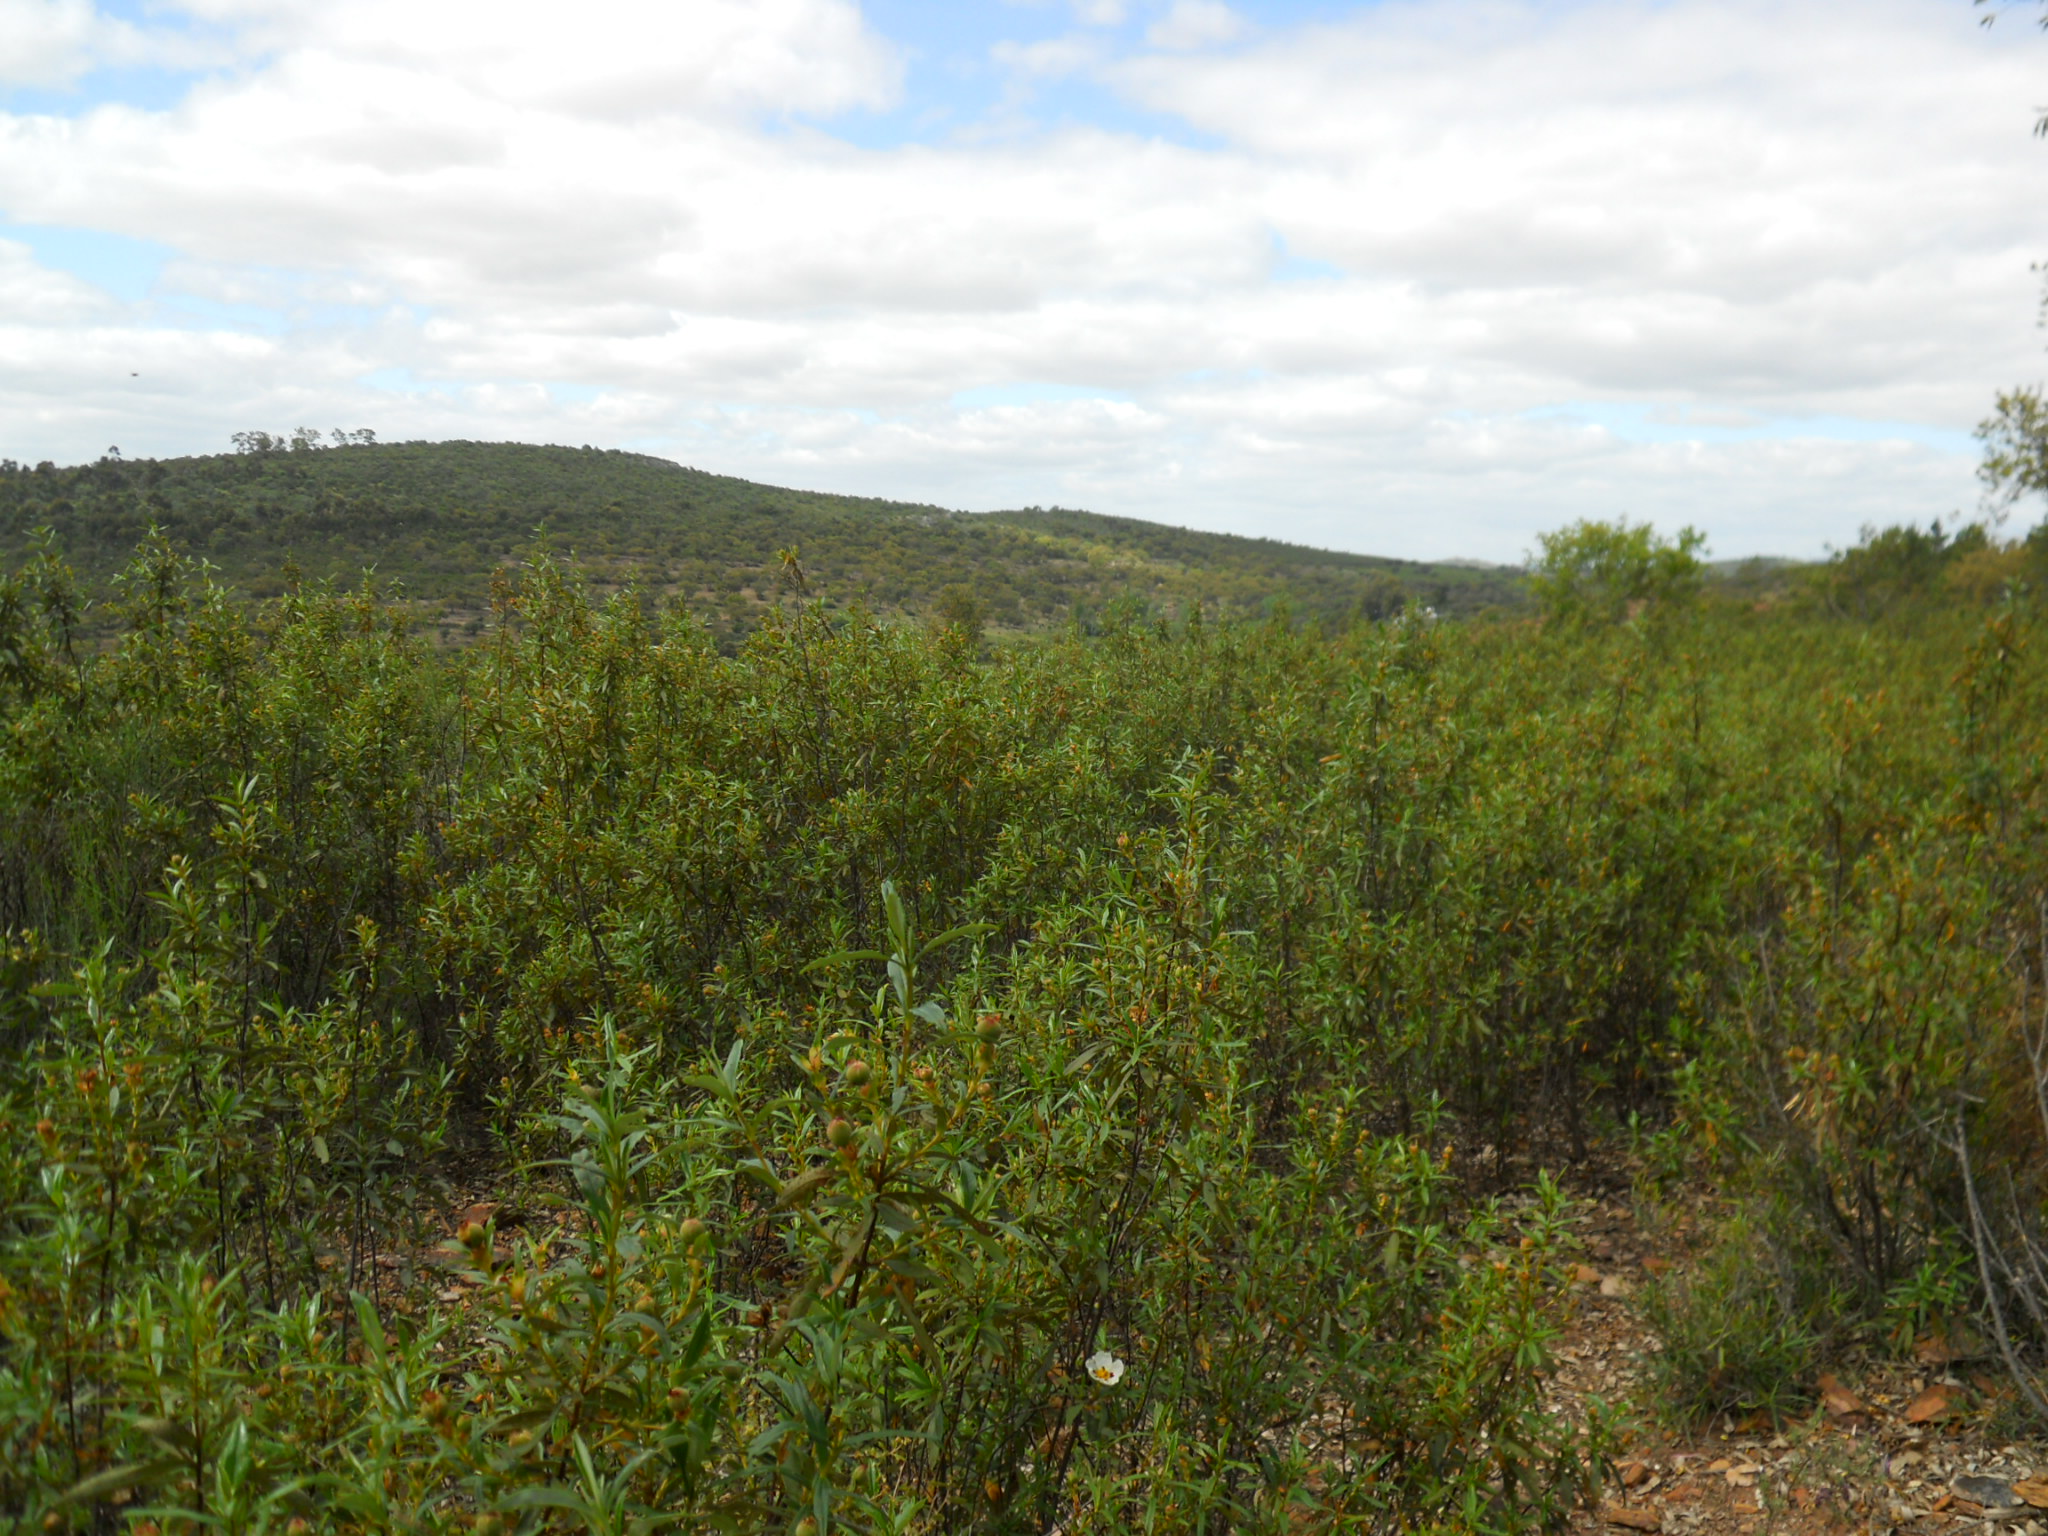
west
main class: Woodland
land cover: Broadleaved woodland
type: broadleaved evergreen forest
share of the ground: > 75 %
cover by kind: broadleaved forest trees 90 %, unconsolidated bare surface 10 %
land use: Forestry
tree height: > 5 m
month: May
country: ES
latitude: 39.1631
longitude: -7.0786
